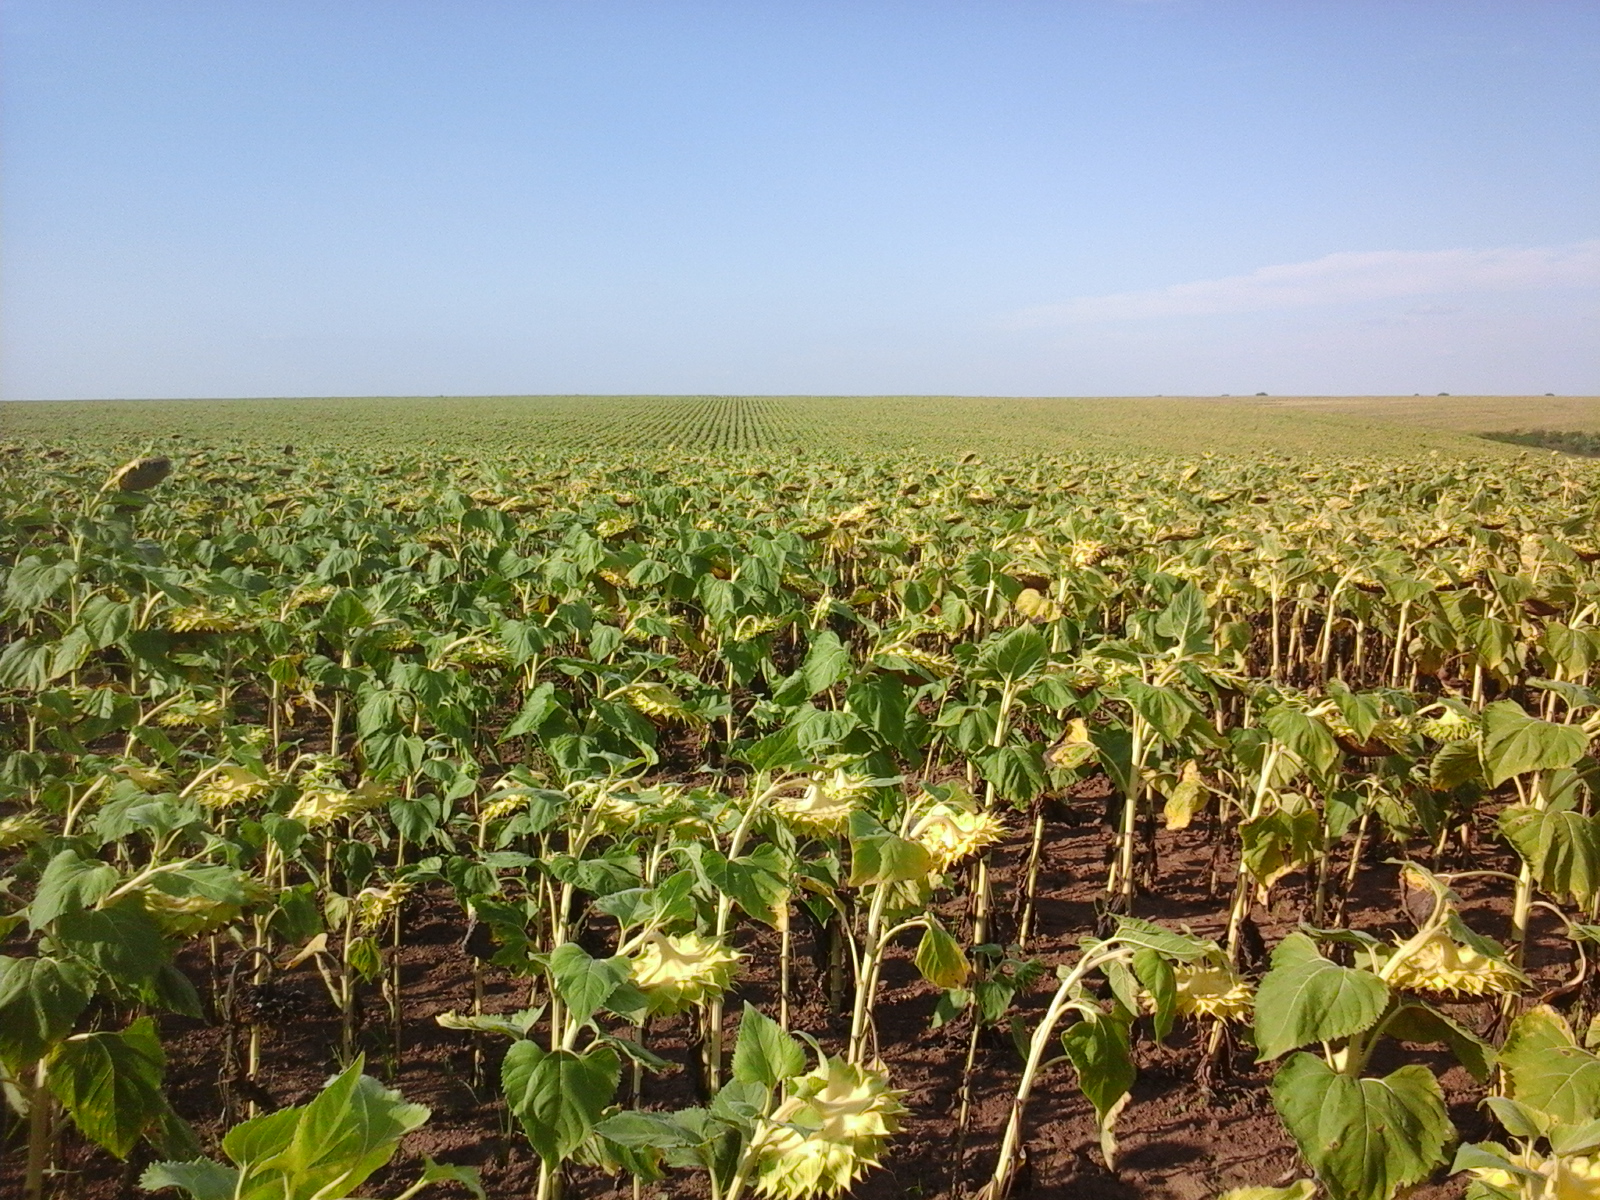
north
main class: Cropland
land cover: Sunflower
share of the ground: > 75 %
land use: Agriculture (excluding fallow land and kitchen gardens)
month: August
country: RO
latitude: 46.0370
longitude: 21.3393
